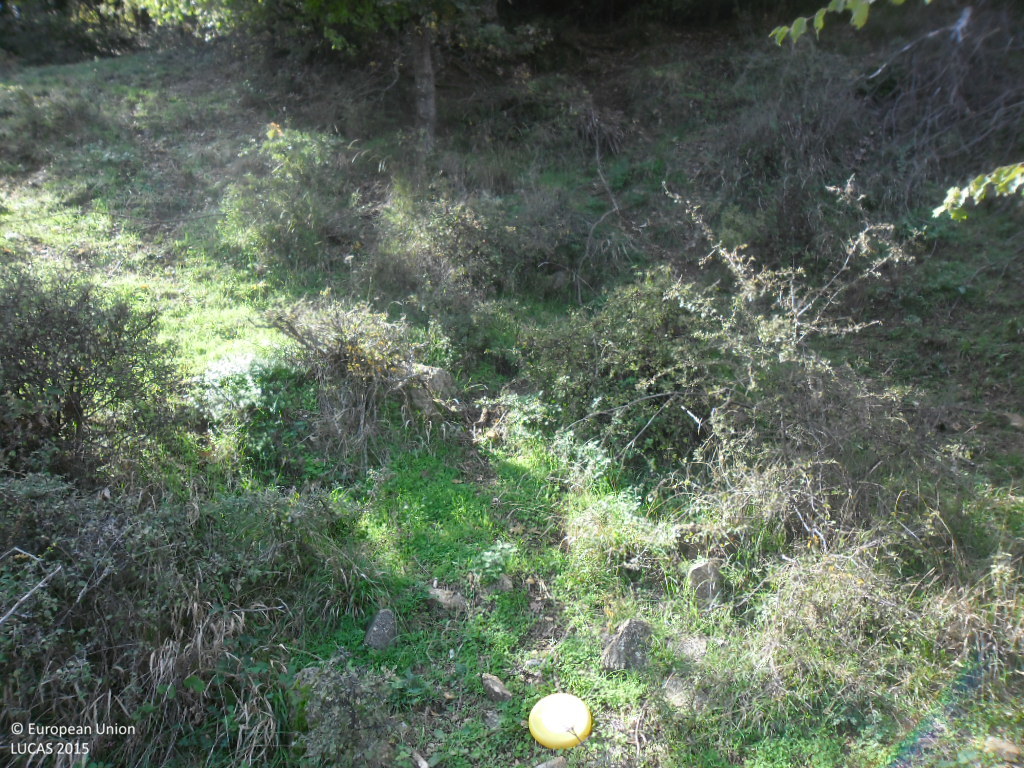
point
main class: Woodland
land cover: Broadleaved woodland
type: mesophytic deciduous forest
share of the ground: > 75 %
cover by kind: broadleaved forest trees 75 %, shrubs 10 %, herbaceous plants 10 %, unconsolidated bare surface 5 %
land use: Forestry
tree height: < 5 m
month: October
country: BG
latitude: 41.5133
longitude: 23.1882
